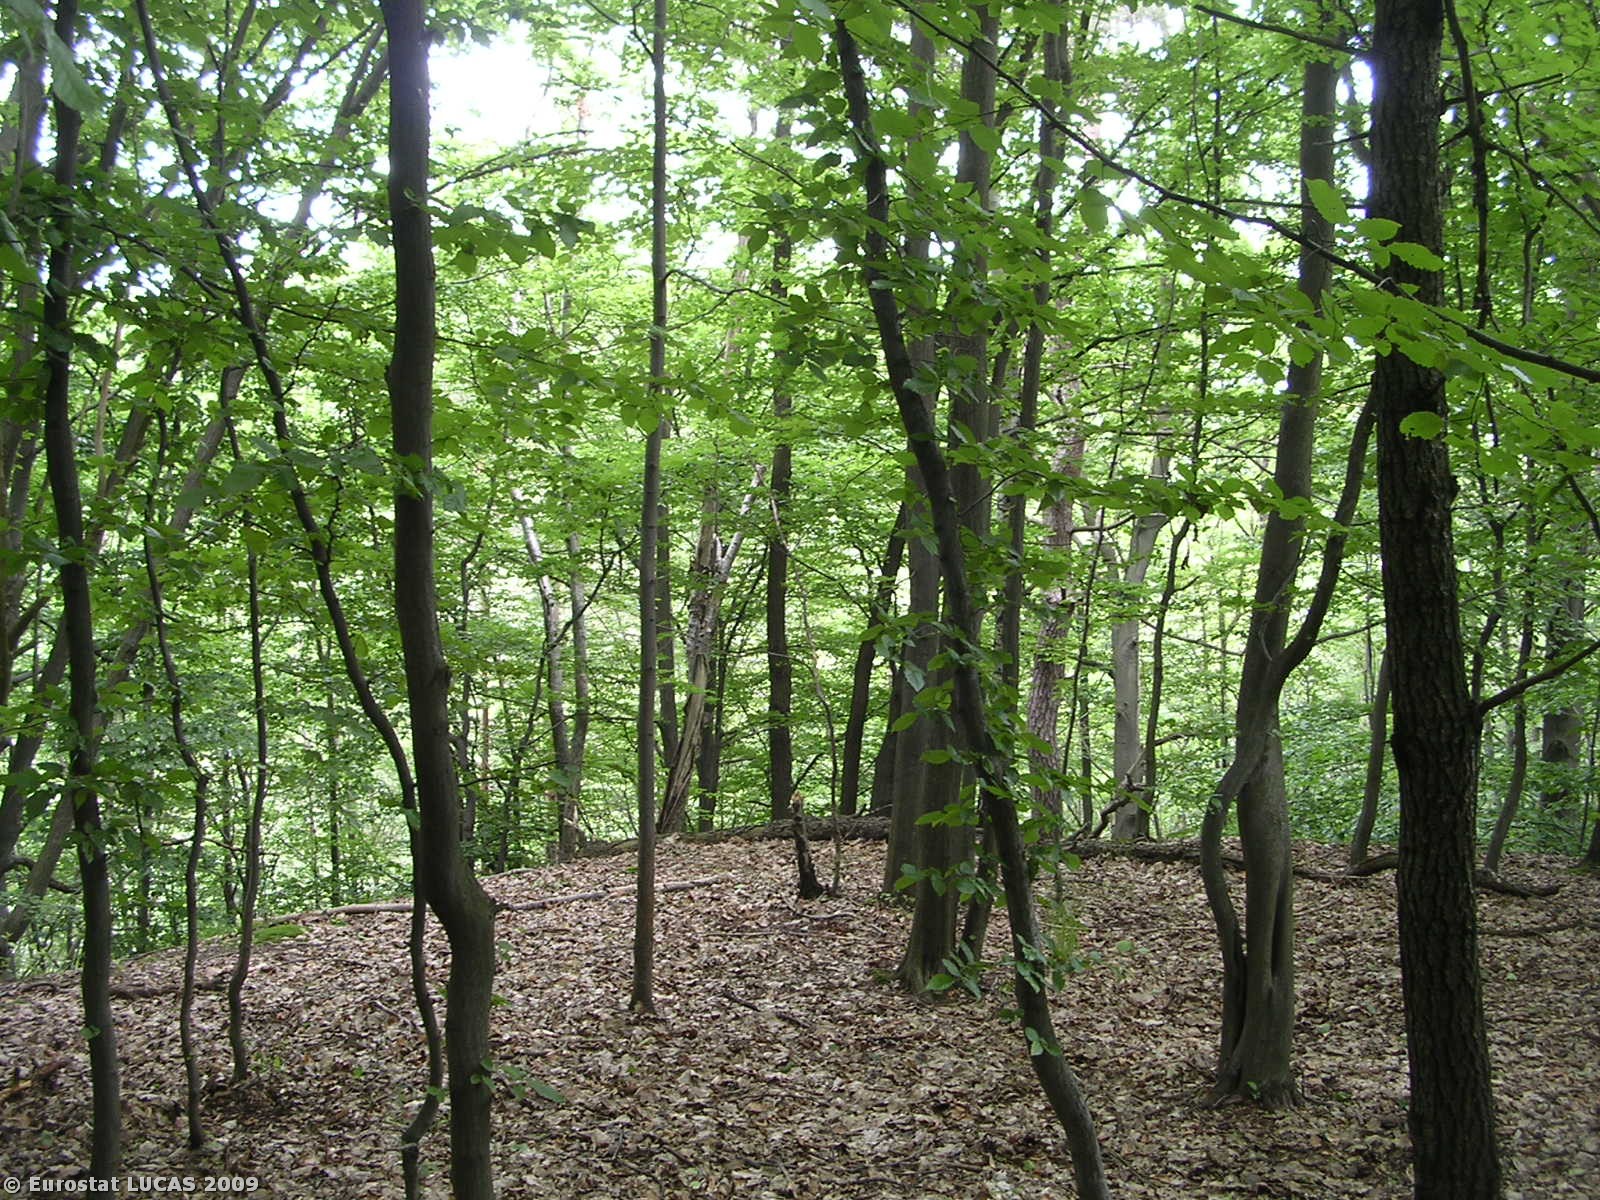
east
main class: Woodland
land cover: Mixed woodland
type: hemiboreal forest and nemoral coniferous forest and mixed broadleaved-coniferous forest
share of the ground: > 75 %
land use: Forestry
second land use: Nature reserves
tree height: > 5 m
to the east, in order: Mixed woodland; Rock outcrops; Mixed woodland; Tracks; Broadleaved woodland; Grassland without tree/shrub cover; Broadleaved woodland; Grassland with sparse tree/shrub cover; Mixed woodland; Rock outcrops; Coniferous woodland; Mixed woodland
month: June
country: CZ
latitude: 50.4682
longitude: 14.6373
